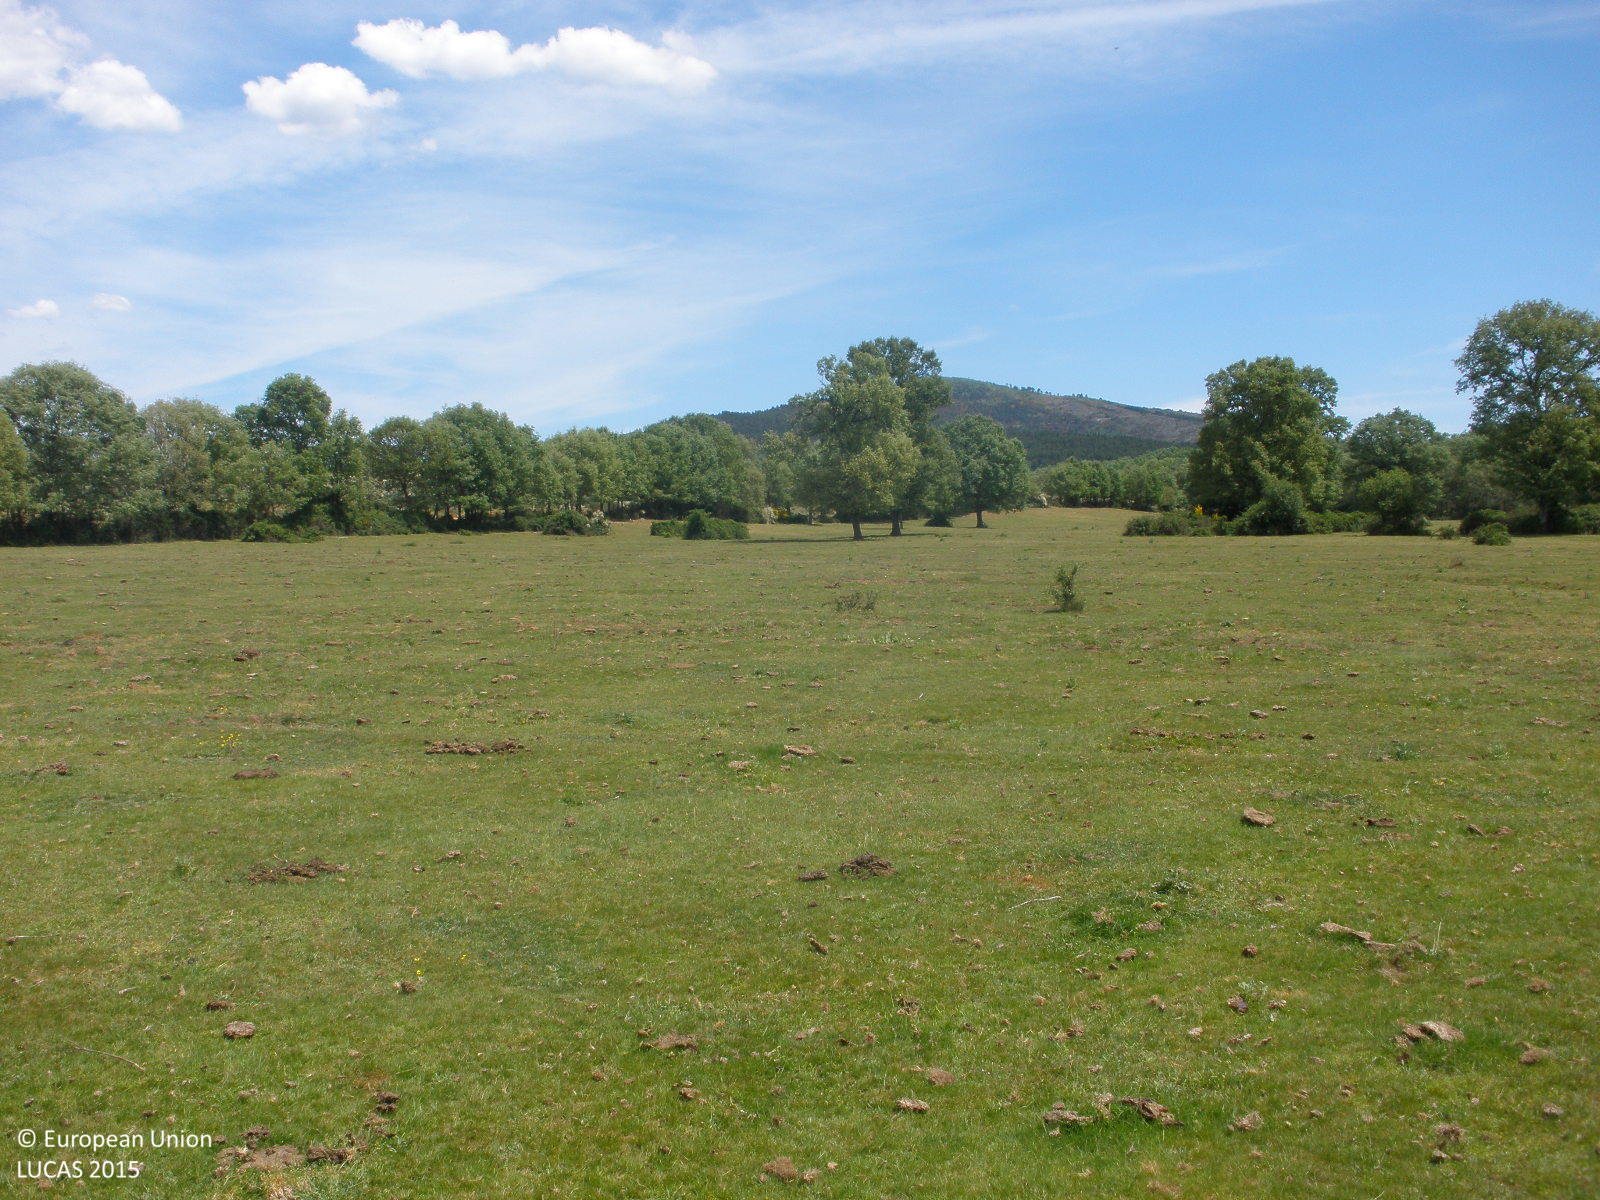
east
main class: Grassland
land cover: Grassland without tree/shrub cover
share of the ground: > 75 %
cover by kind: herbaceous plants 100 %
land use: Agriculture (excluding fallow land and kitchen gardens)
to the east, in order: Grassland without tree/shrub cover; Lines of trees; Tracks; Grassland without tree/shrub cover; Shrubland with sparse tree cover
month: May
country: ES
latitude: 40.3300
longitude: -6.6245
